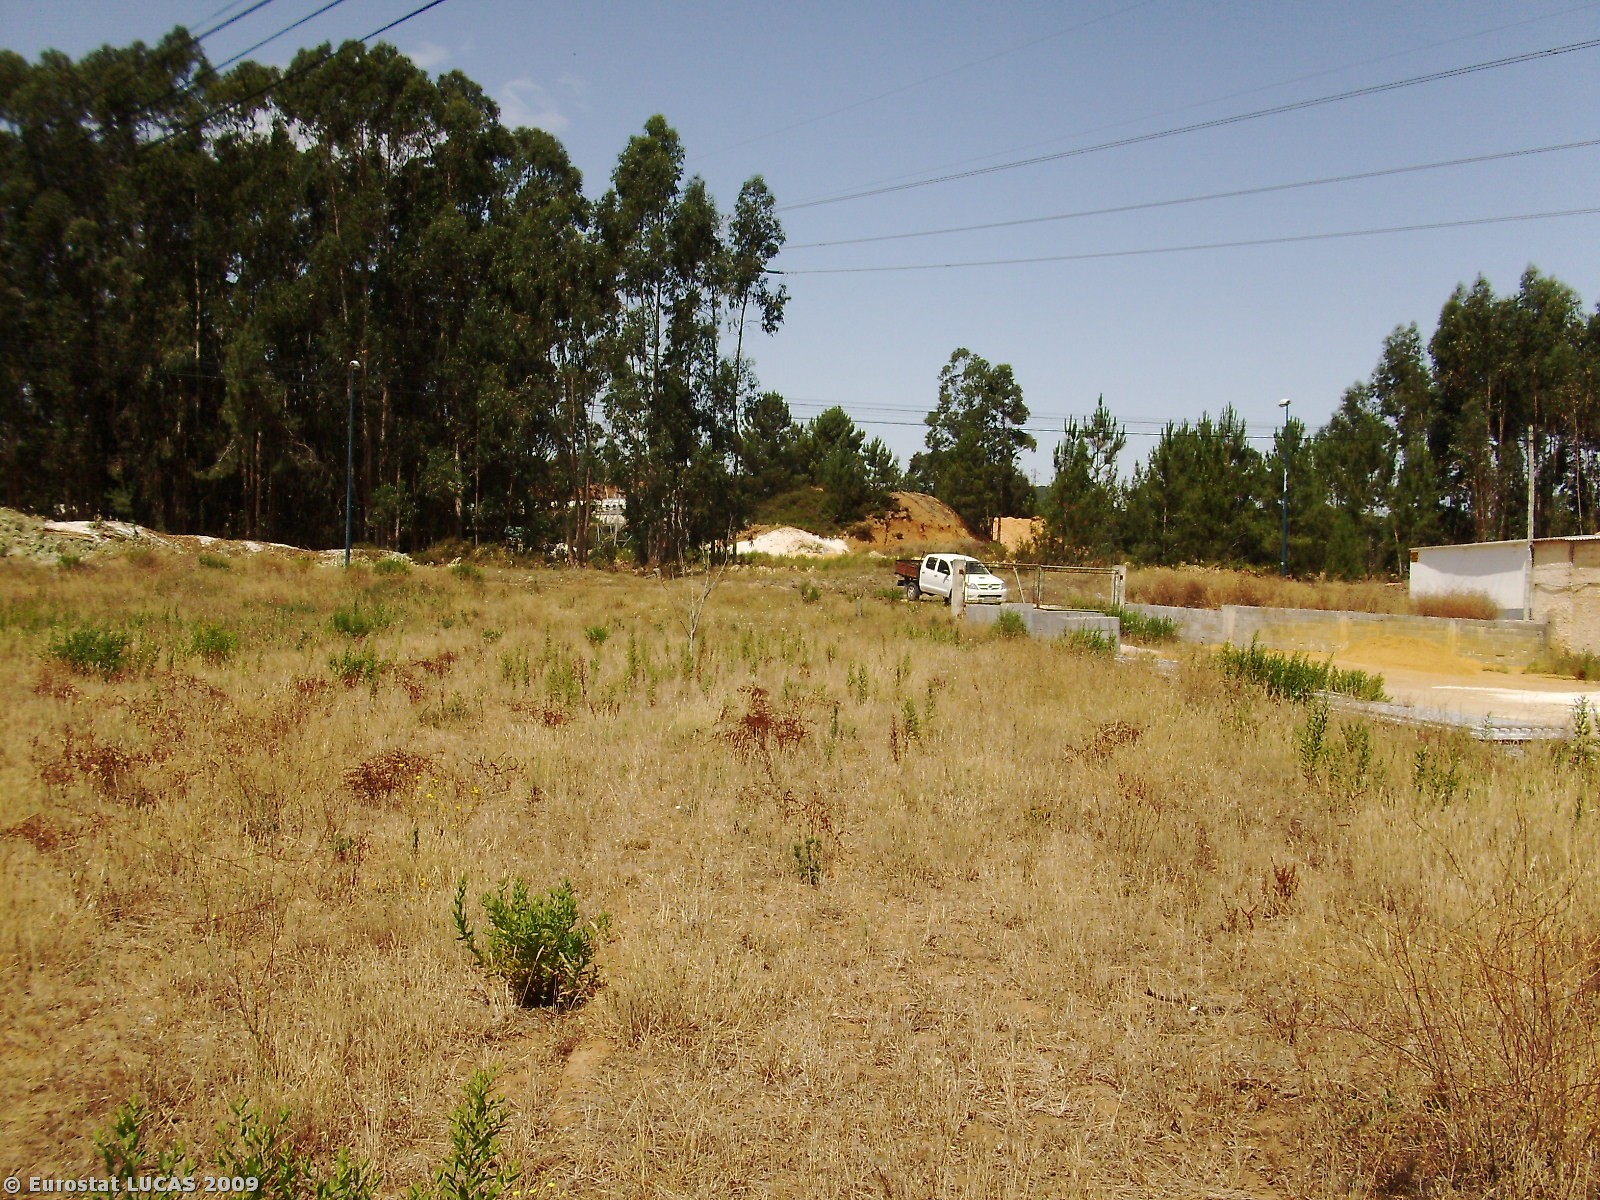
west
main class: Grassland
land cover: Spontaneously vegetated surfaces
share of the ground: > 75 %
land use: Fallow land
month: July
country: PT
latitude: 39.3484
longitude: -8.9381
